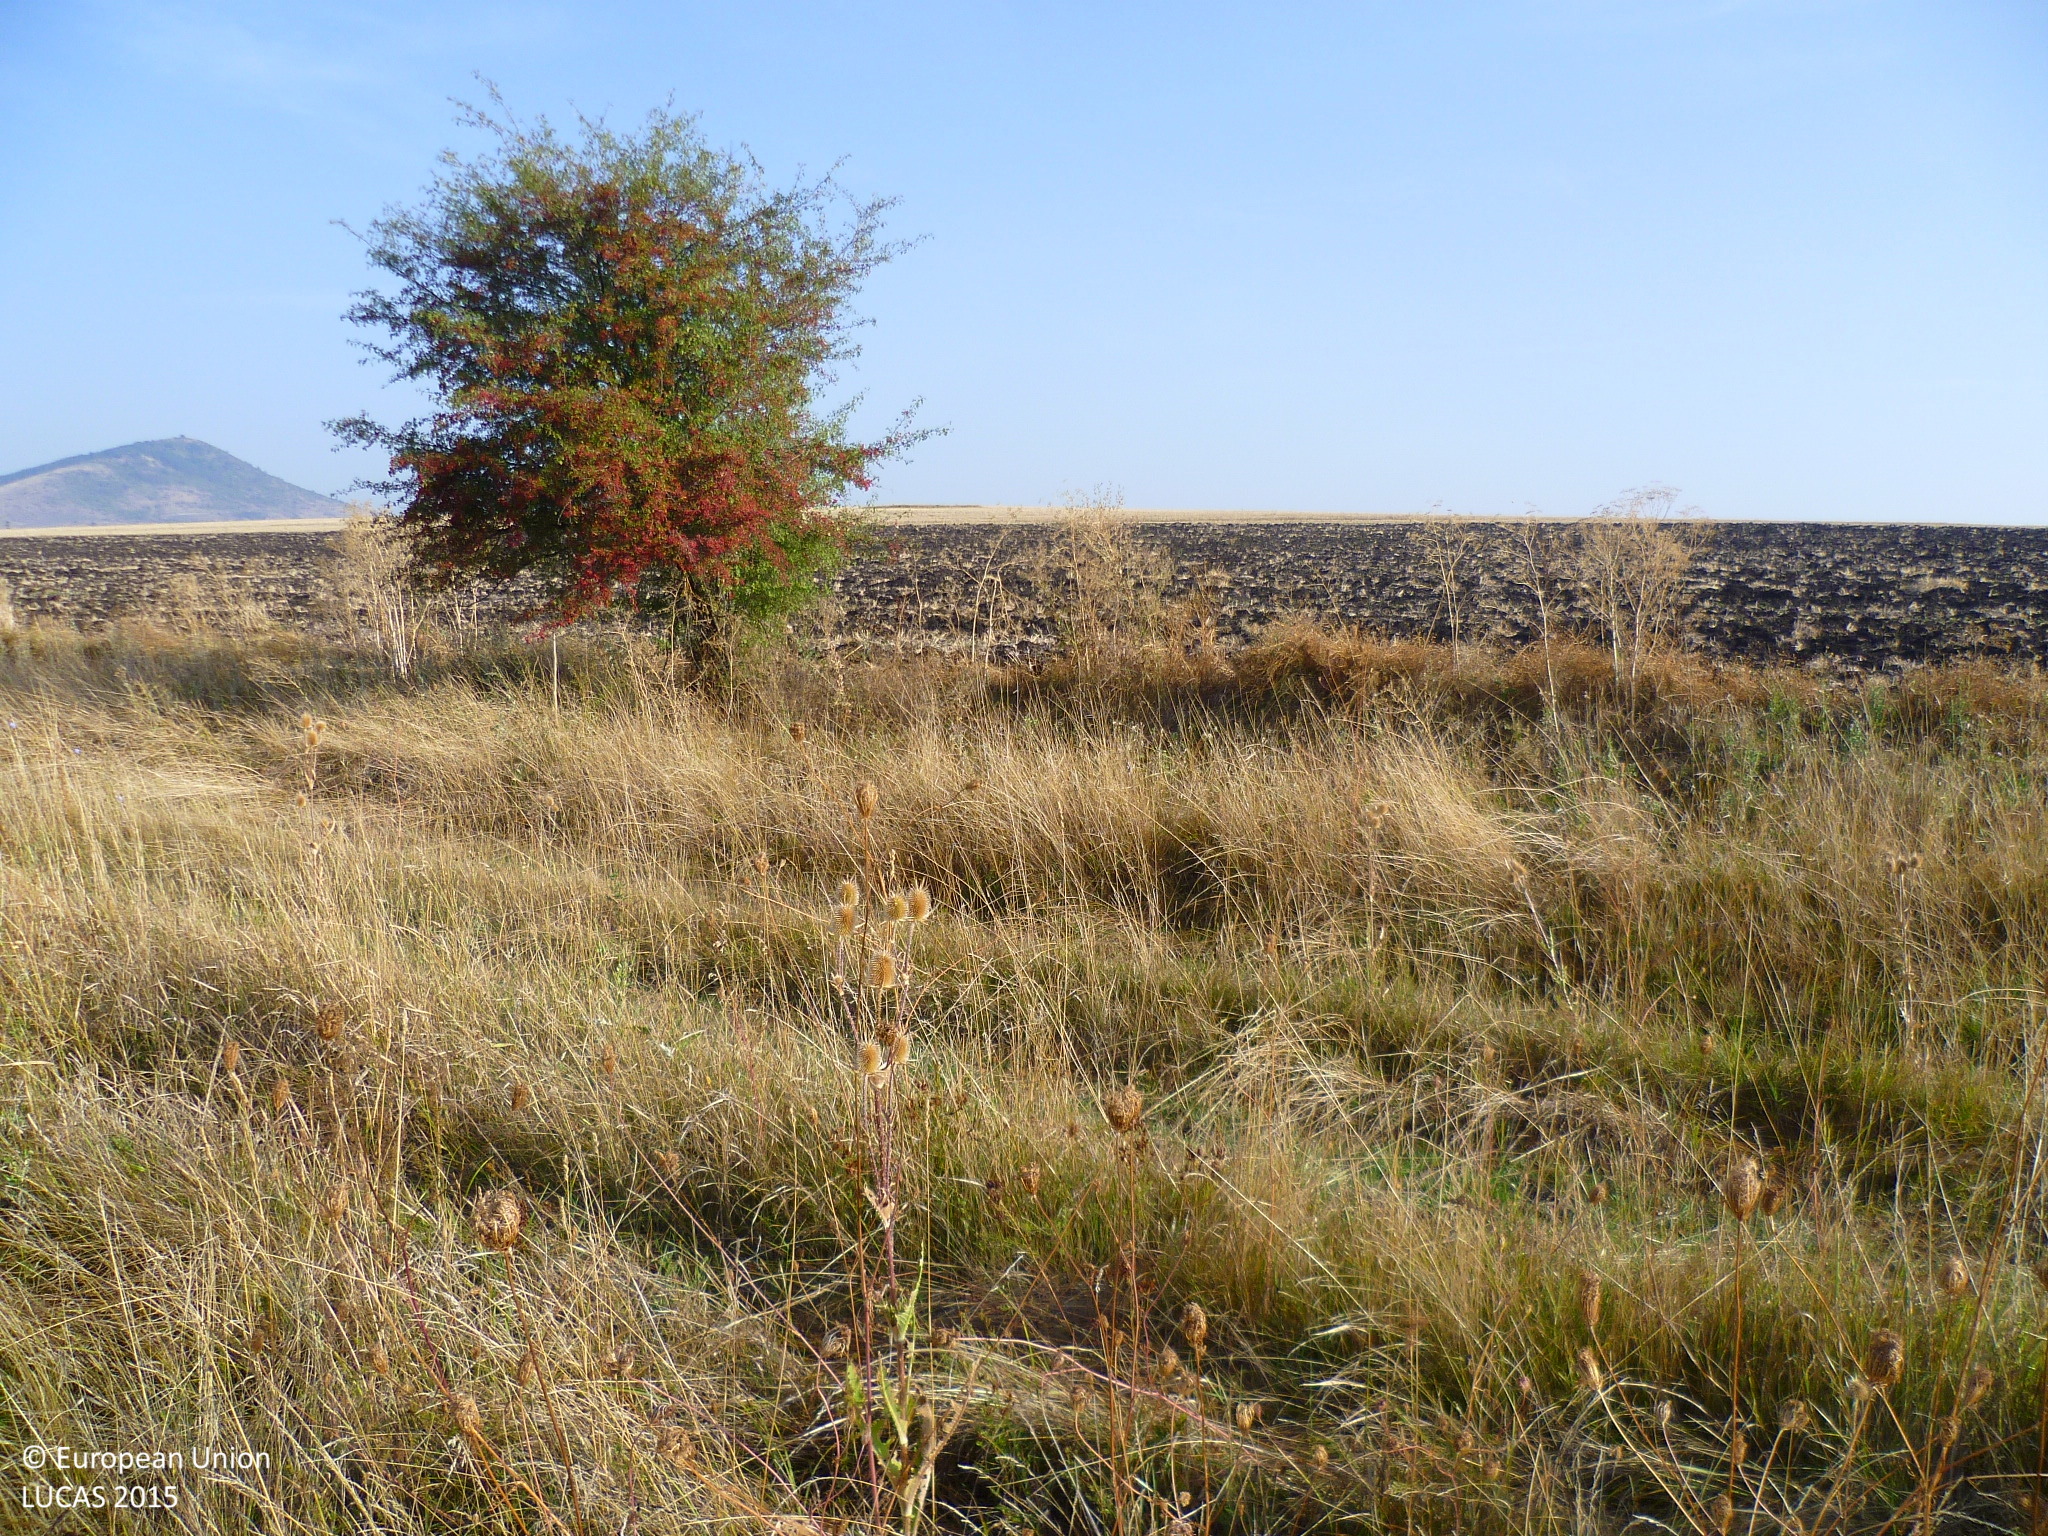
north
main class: Grassland
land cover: Grassland without tree/shrub cover
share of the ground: > 75 %
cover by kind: herbaceous plants 100 %
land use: Agriculture (excluding fallow land and kitchen gardens)
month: September
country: BG
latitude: 42.6885
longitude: 23.0039
